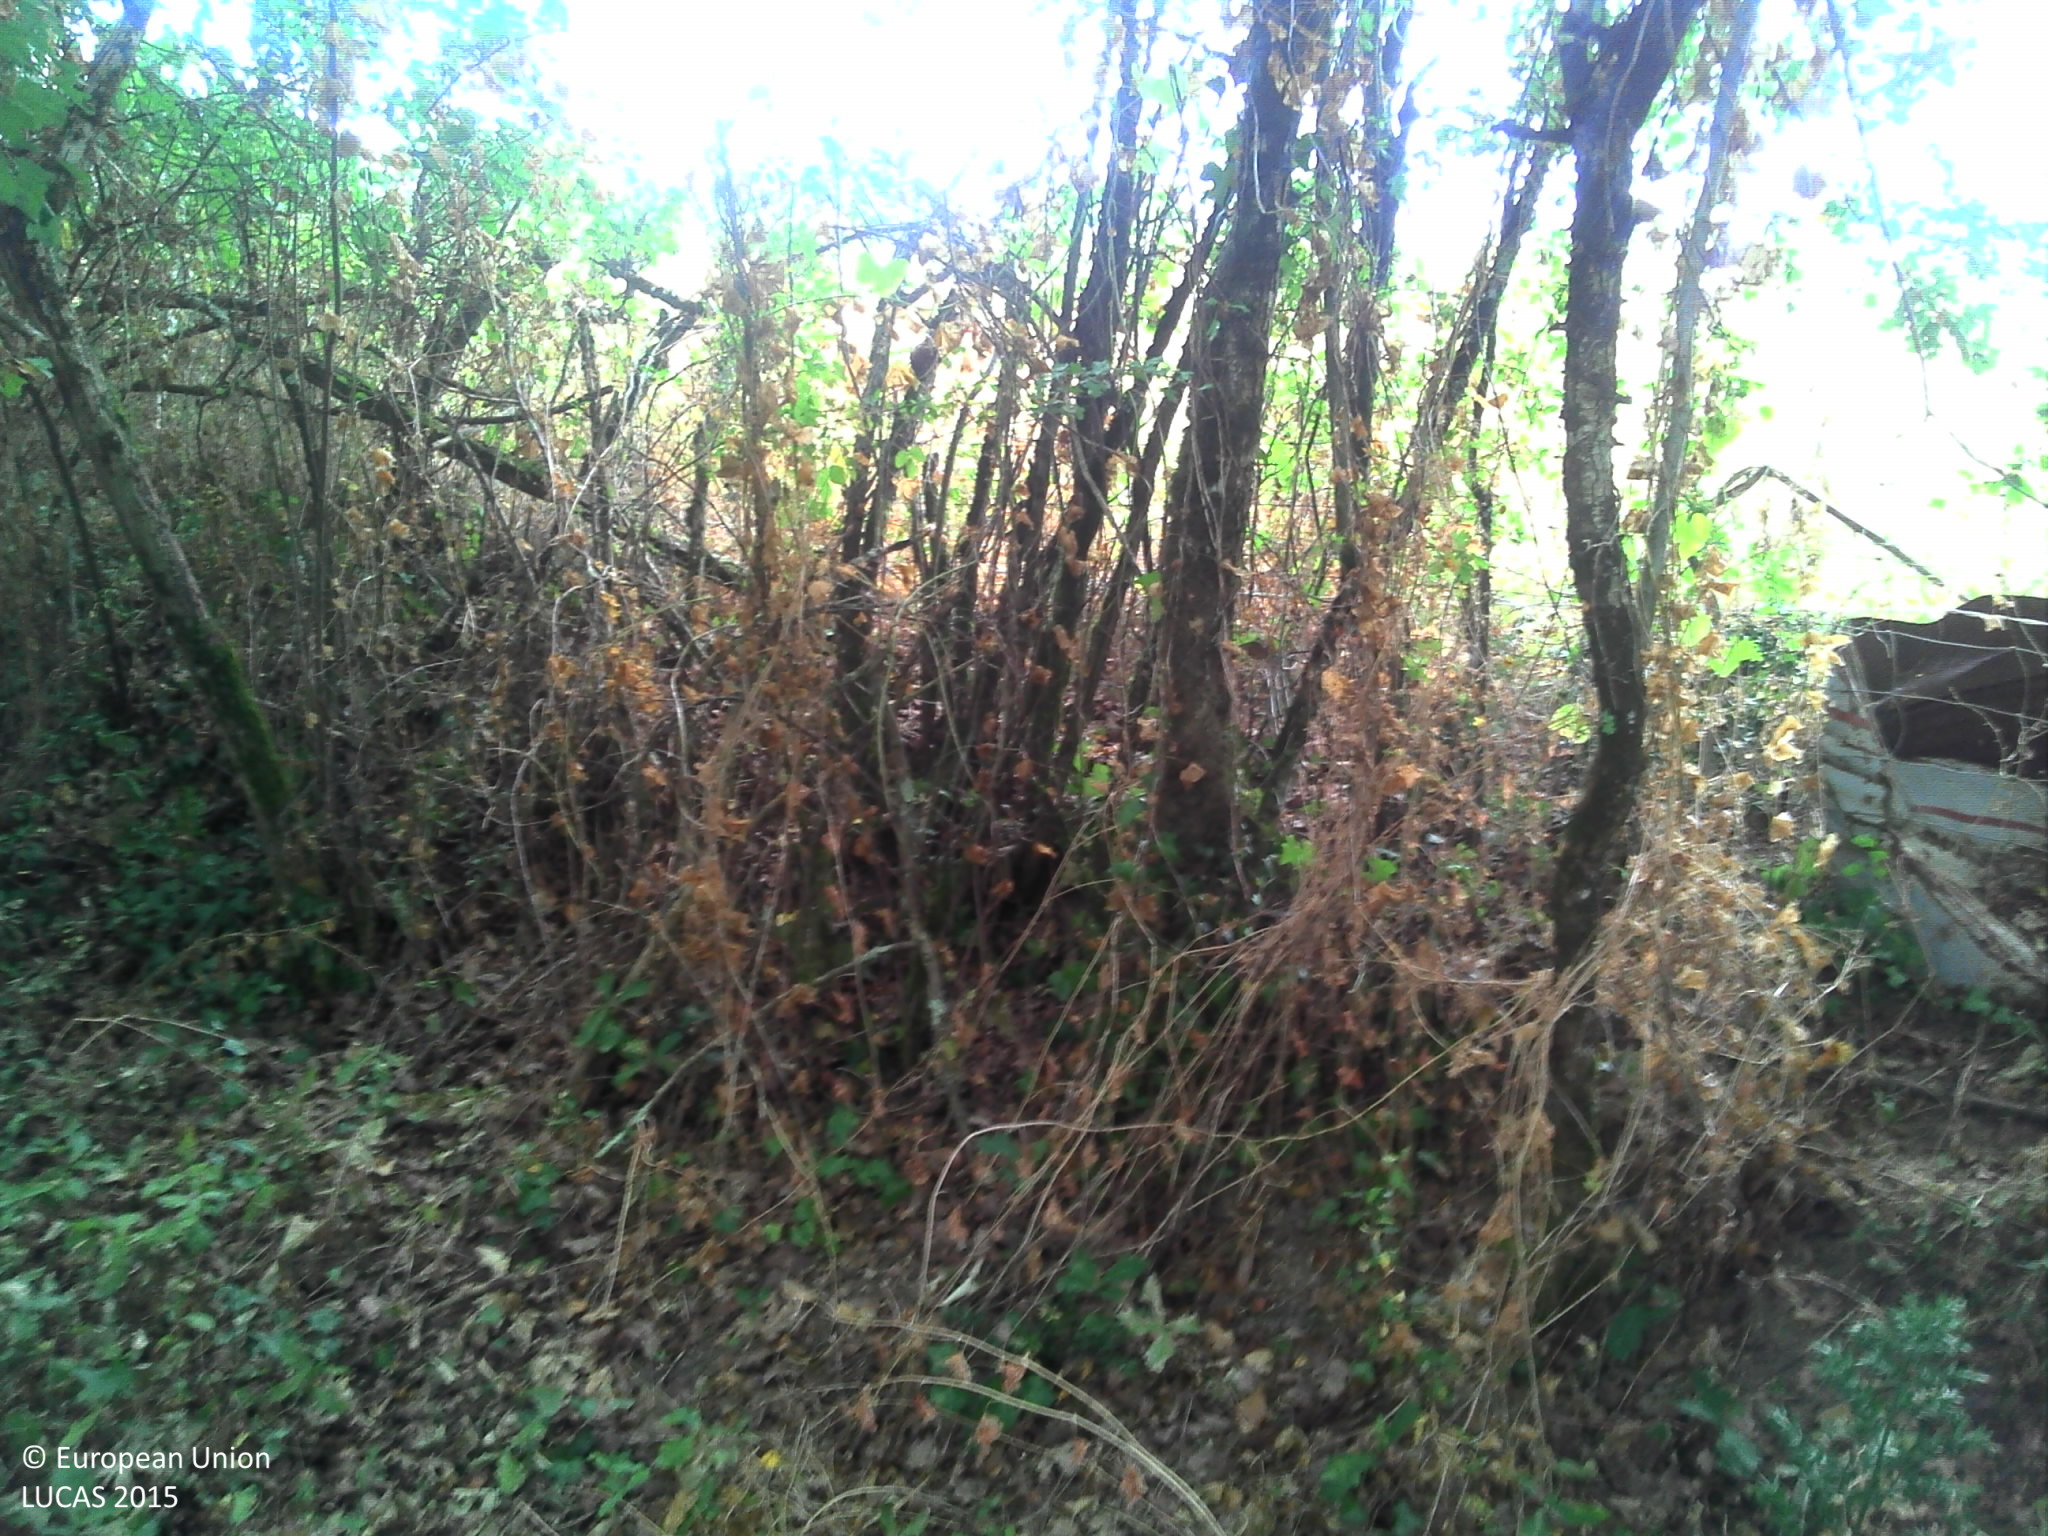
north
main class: Woodland
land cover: Broadleaved woodland
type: mesophytic deciduous forest
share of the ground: > 75 %
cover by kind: broadleaved forest trees 80 %, herbaceous plants 15 %
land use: Forestry
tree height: > 5 m
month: October
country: FR
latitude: 46.3316
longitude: 1.1940
